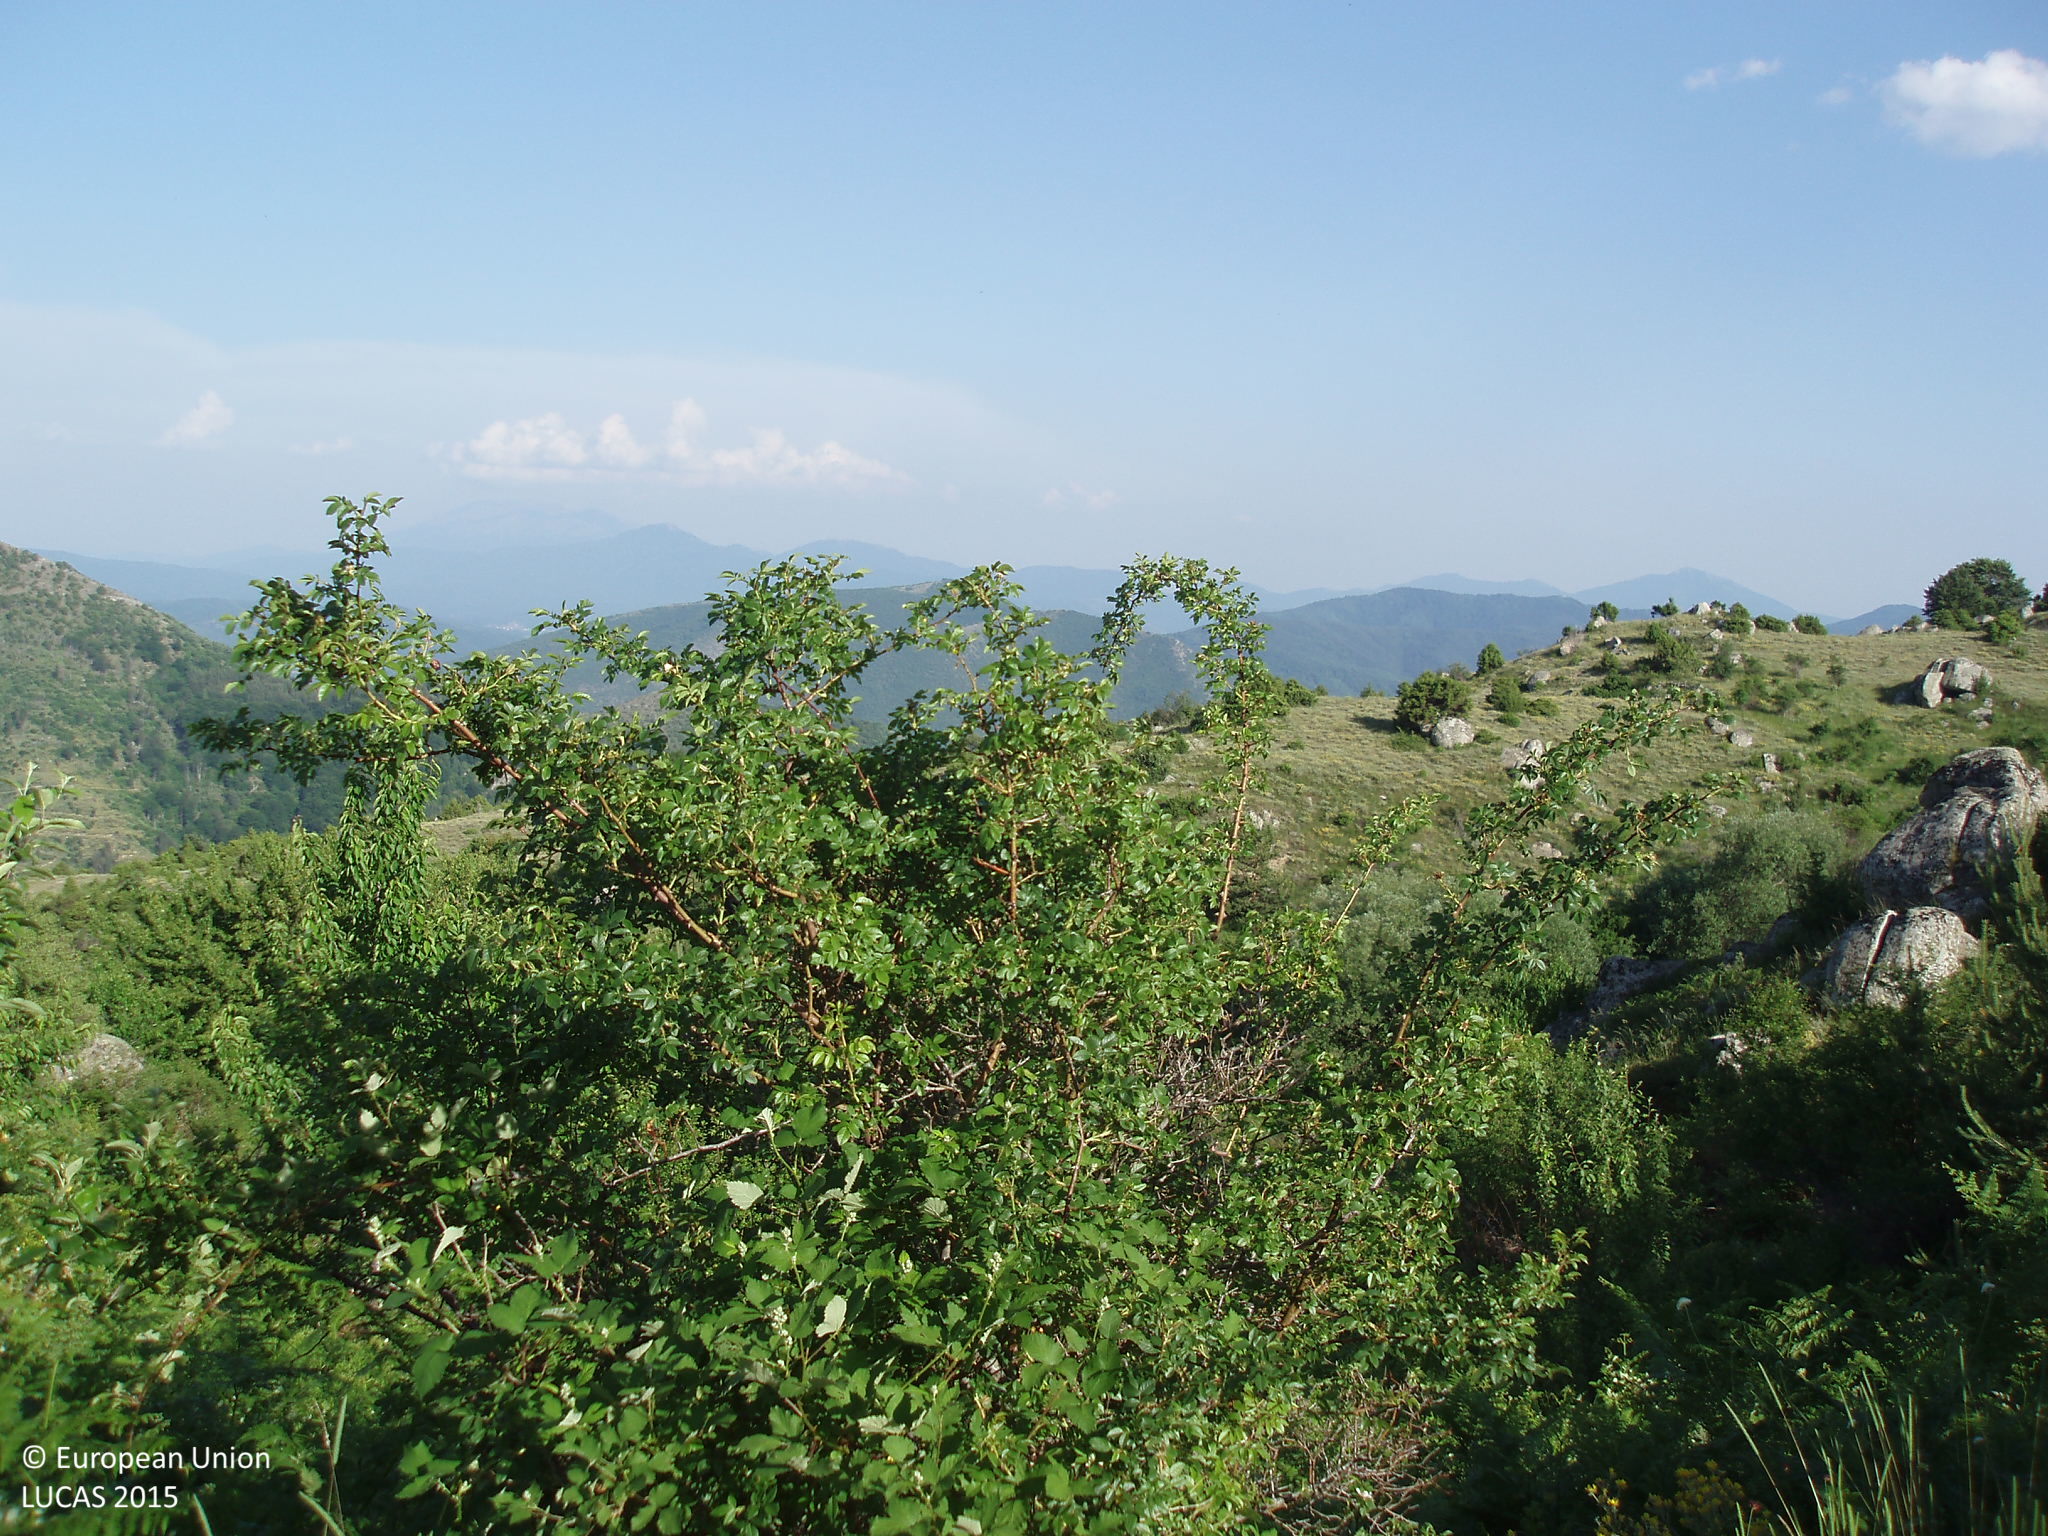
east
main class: Shrubland
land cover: Shrubland with sparse tree cover
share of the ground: 50 - 75 %
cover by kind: shrubs 65 %, herbaceous plants 30 %, broadleaved forest trees 5 %
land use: Semi-natural and natural areas not in use
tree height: < 5 m
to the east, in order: Shrubland with sparse tree cover; Other bare soil; Shrubland without tree cover; Rocks and stones; Shrubland with sparse tree cover
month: June
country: BG
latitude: 41.4960
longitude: 23.7189
